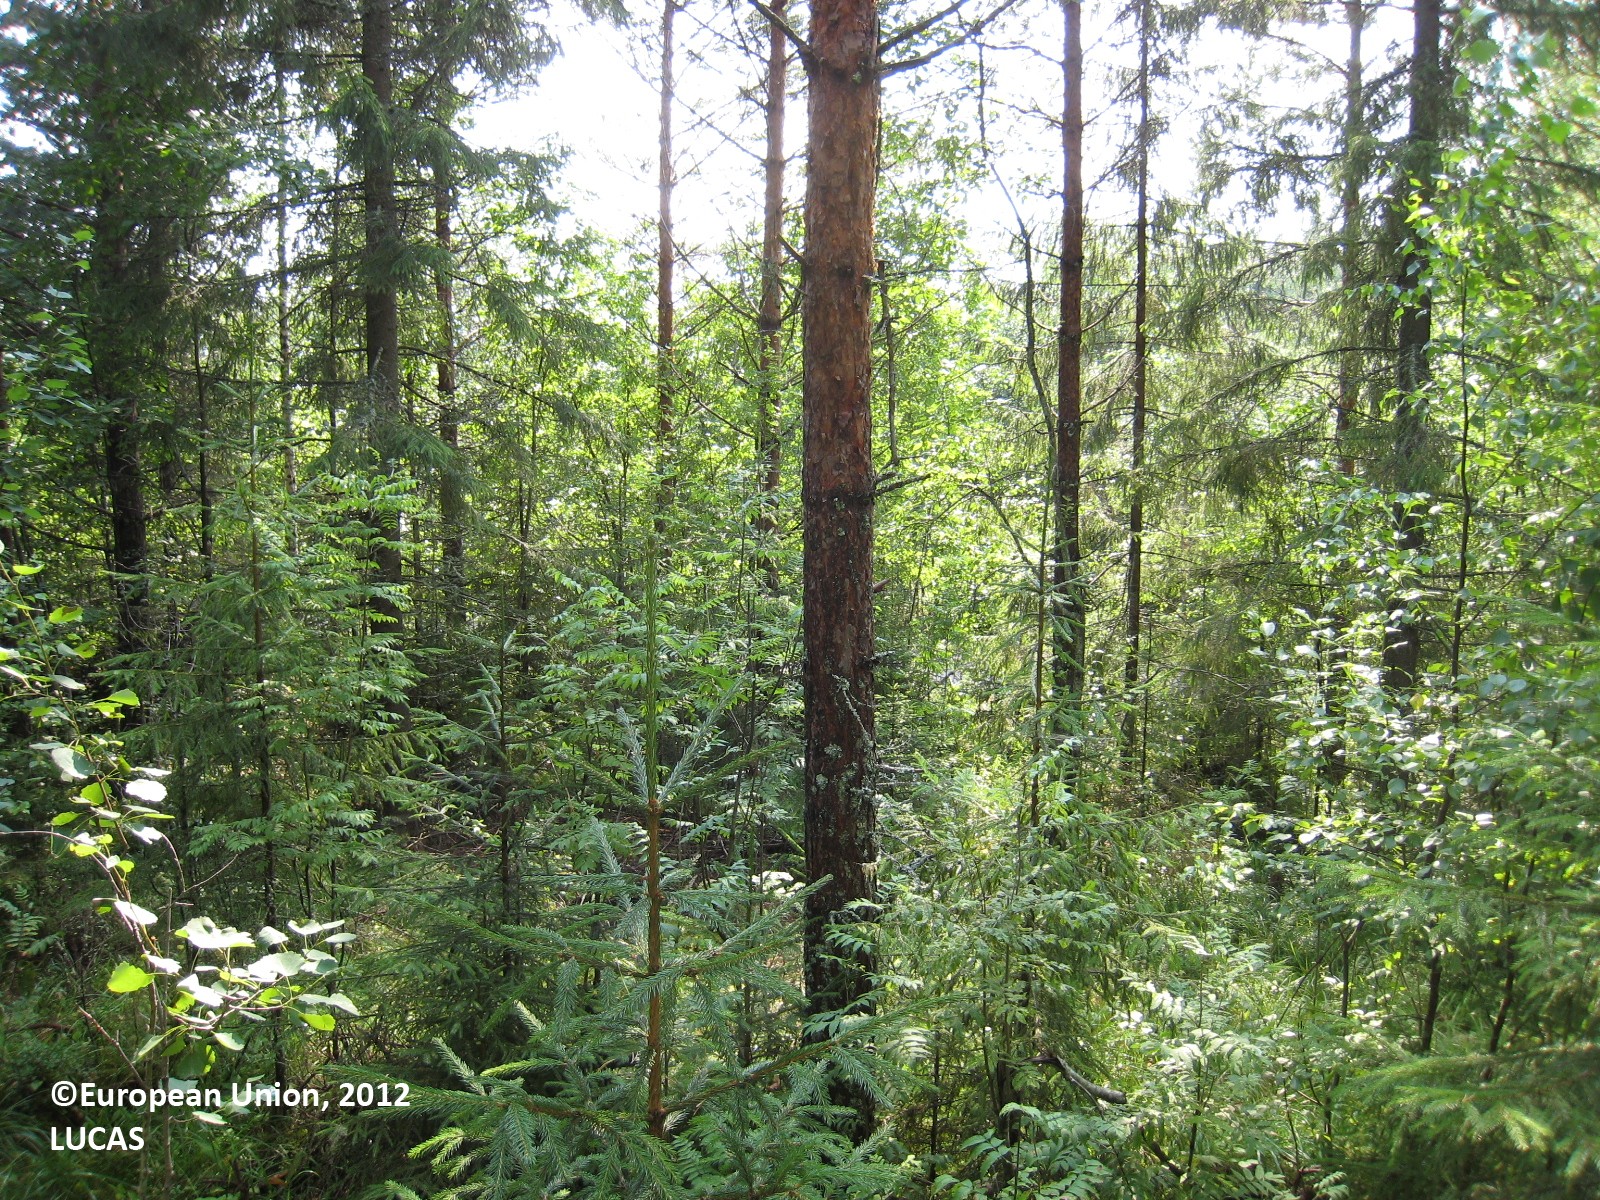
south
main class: Woodland
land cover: Other coniferous woodland
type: boreal forest
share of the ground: > 75 %
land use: Forestry
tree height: > 5 m
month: July
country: FI
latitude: 62.4588
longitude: 27.3985
